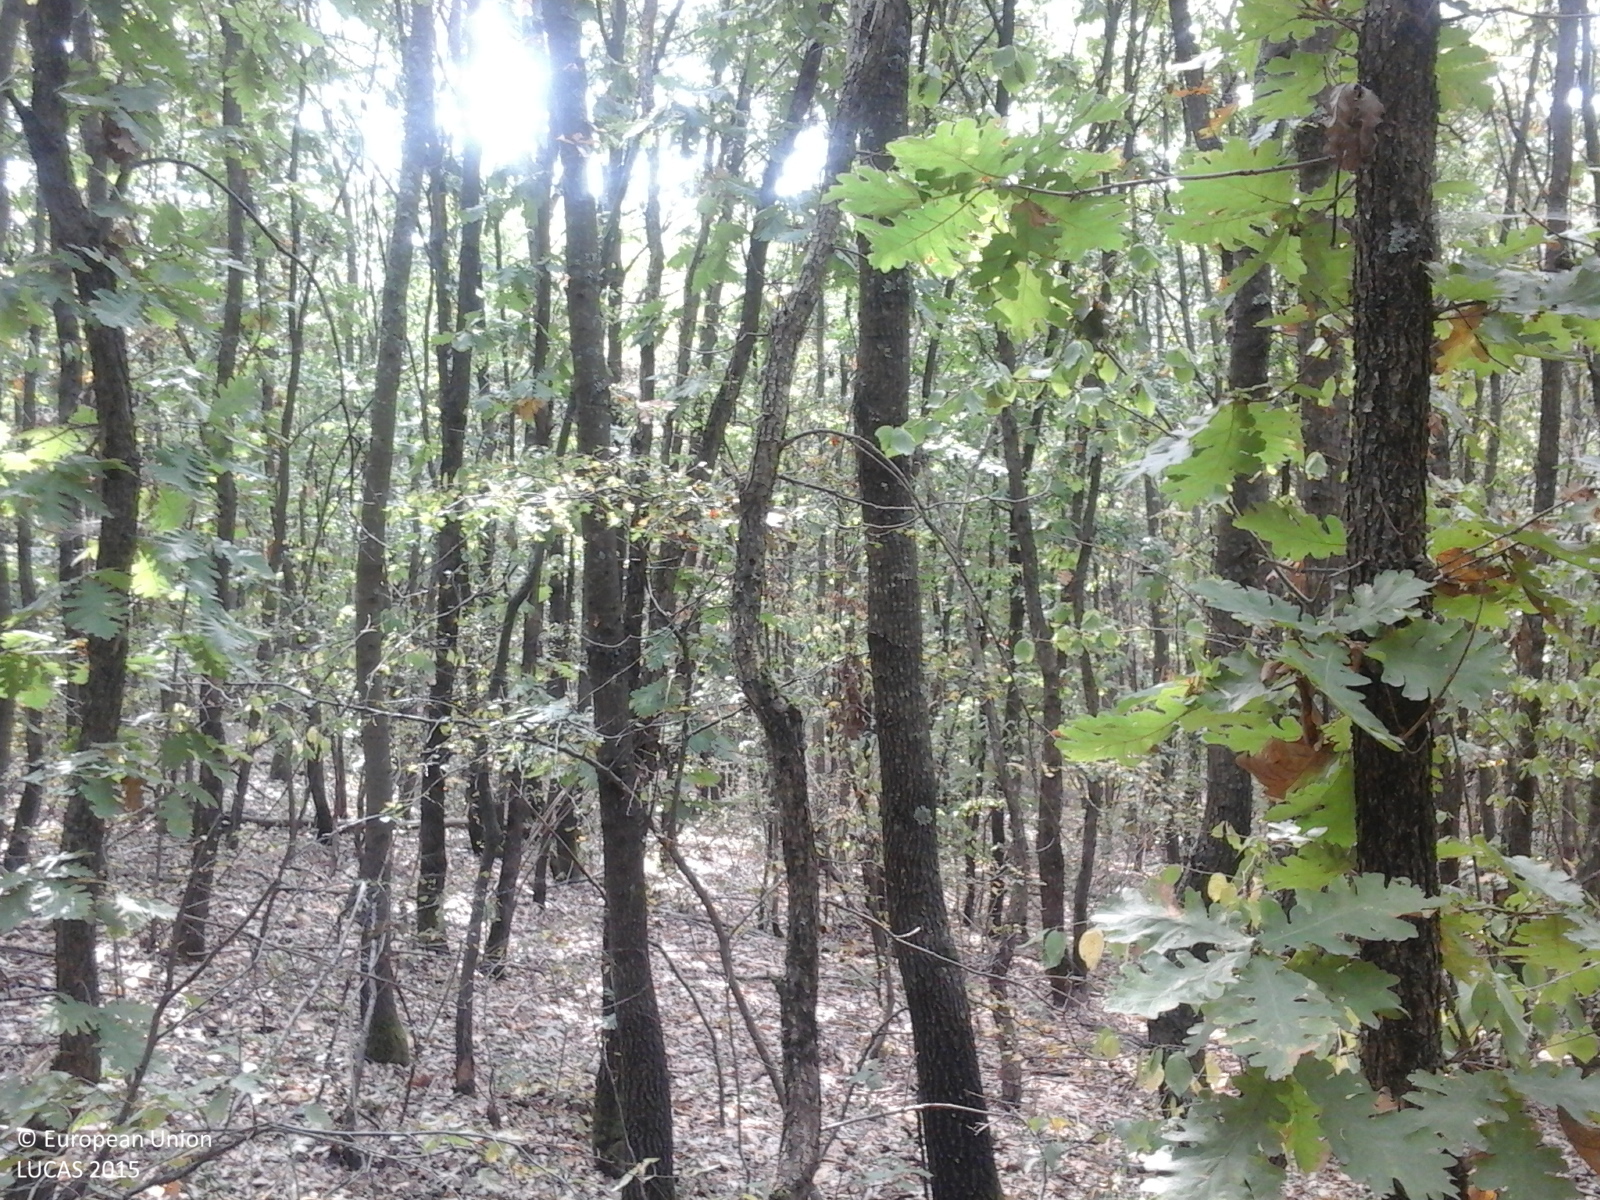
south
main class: Woodland
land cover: Broadleaved woodland
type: acidophilous oak and oak-birch forest
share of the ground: > 75 %
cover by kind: broadleaved forest trees 100 %
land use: Forestry
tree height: > 5 m
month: September
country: RO
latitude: 45.6946
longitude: 21.9695
